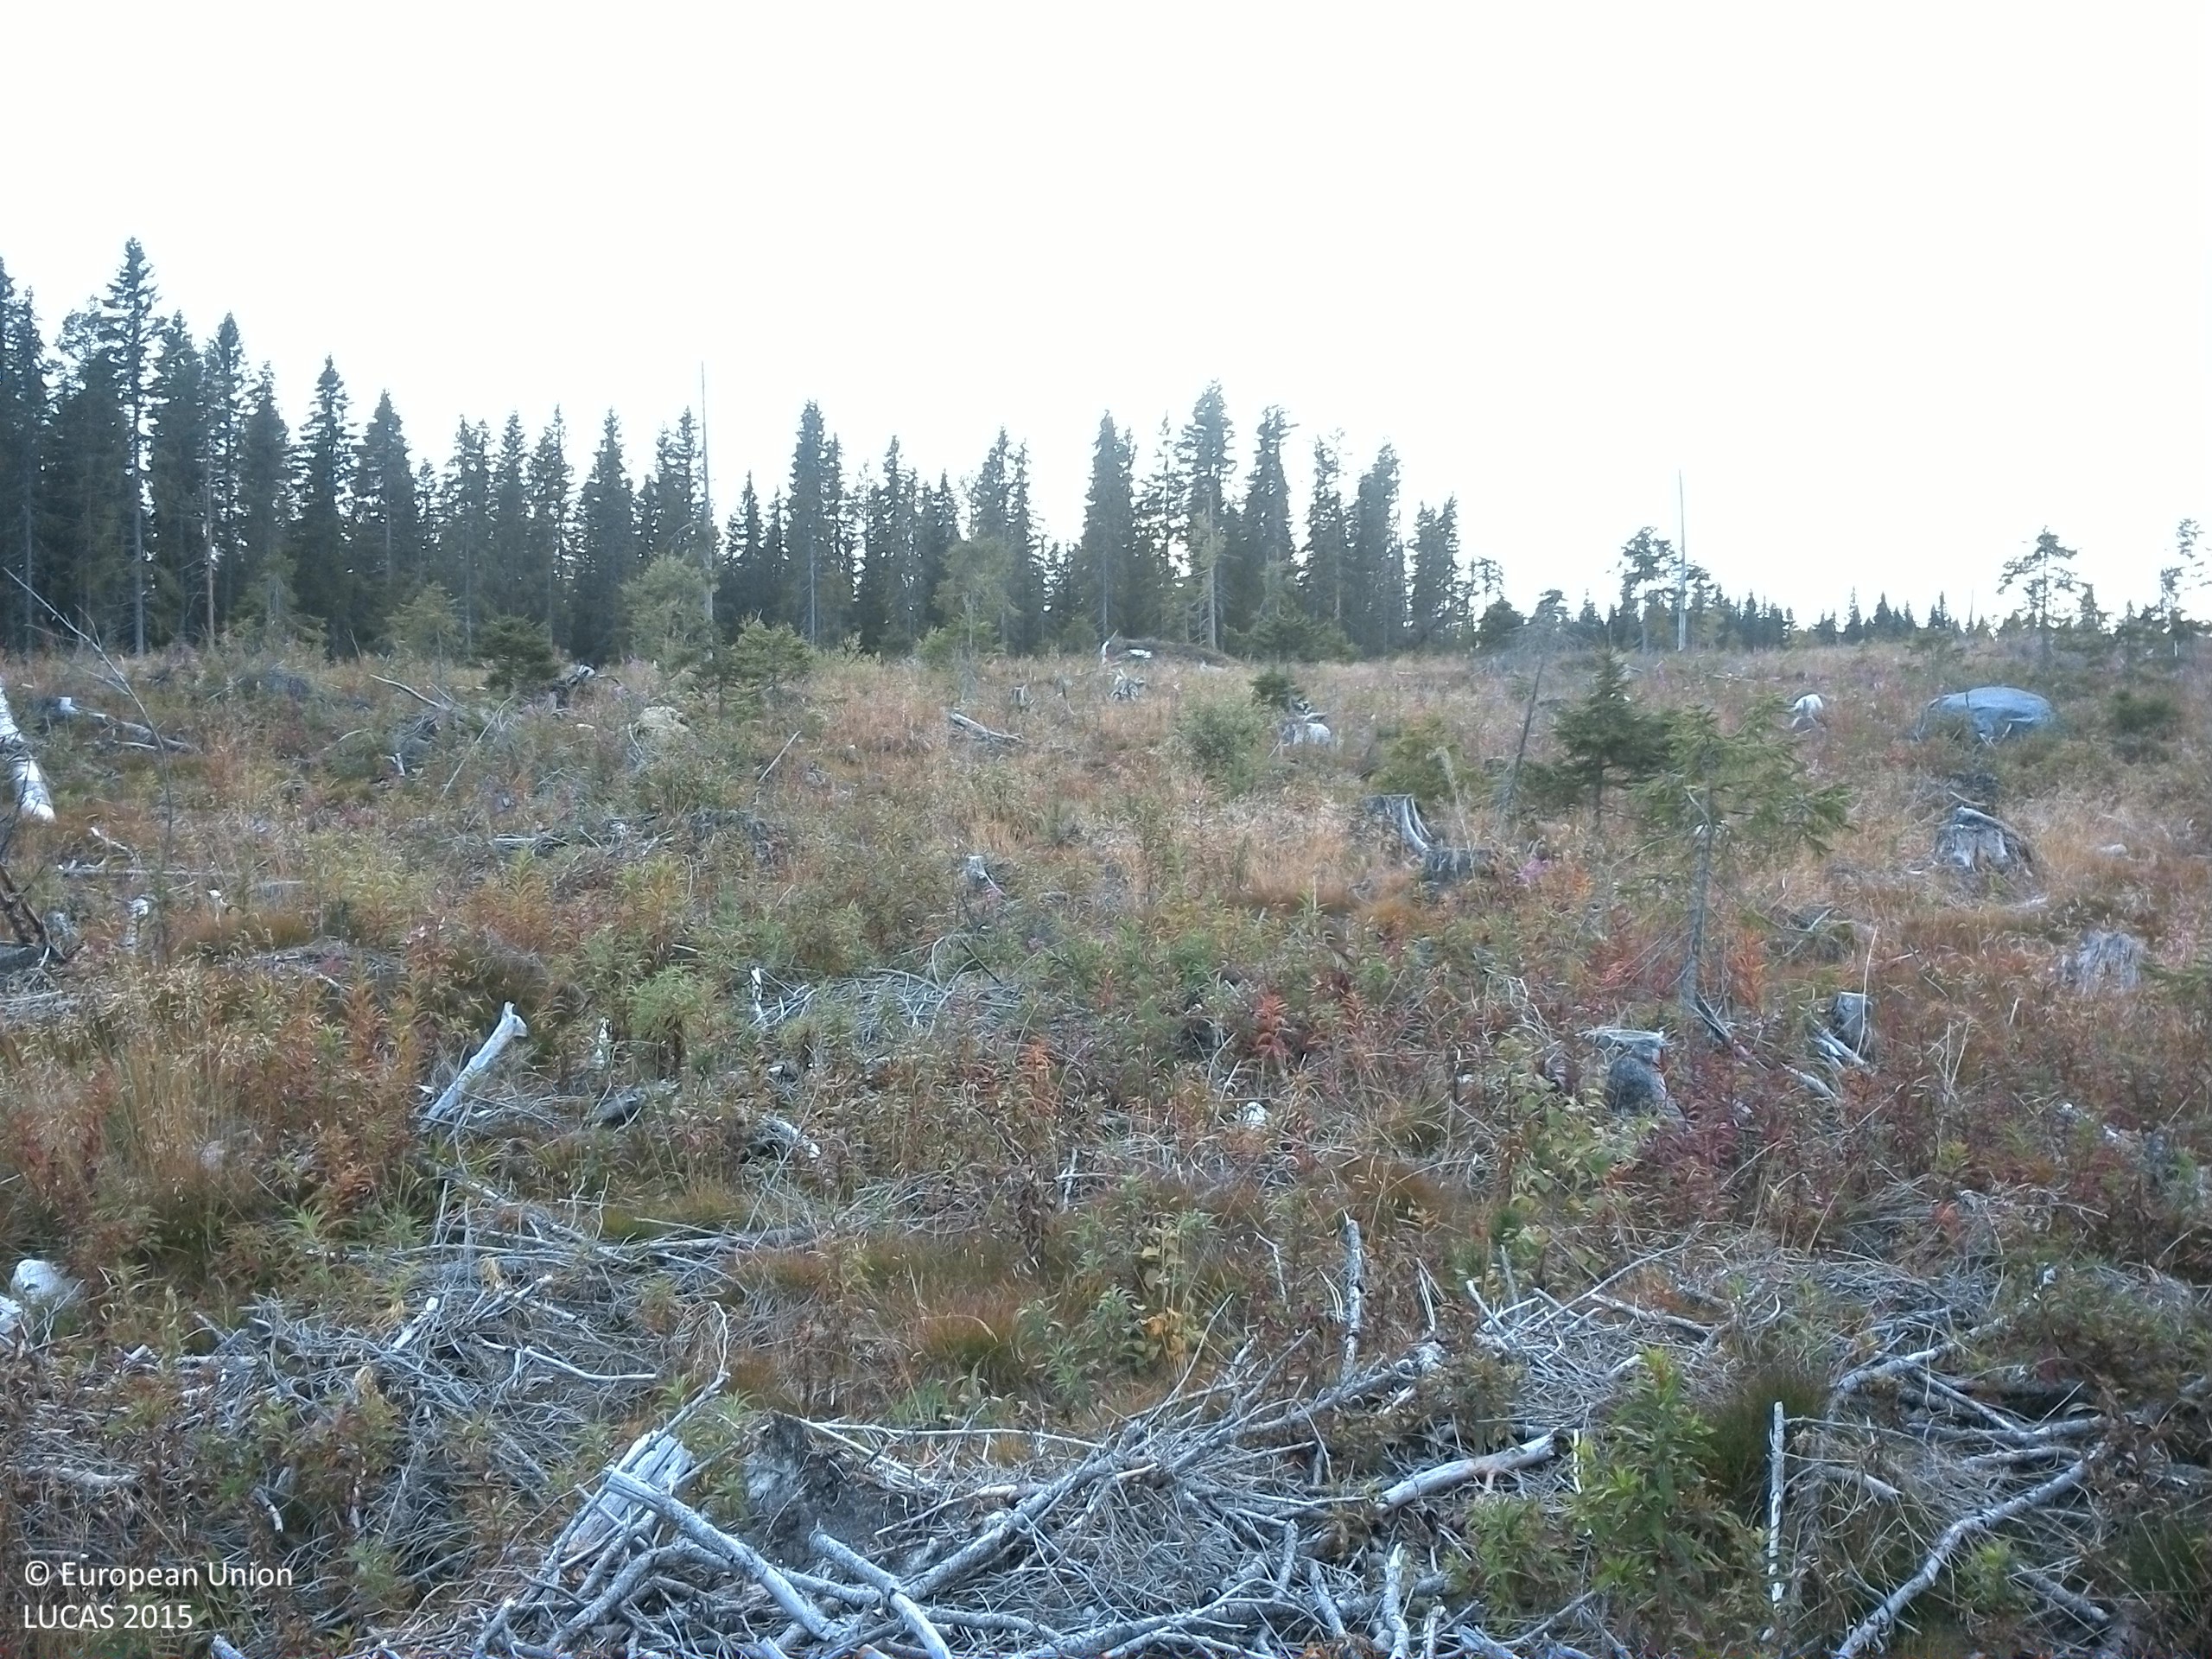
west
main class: Grassland
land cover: Grassland with sparse tree/shrub cover
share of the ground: > 75 %
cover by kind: herbaceous plants 85 %, coniferous forest trees 5 %, lichens and mosses 5 %, unconsolidated bare surface 5 %
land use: Forestry
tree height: < 5 m
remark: Clear cut
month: September
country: SE
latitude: 64.0799
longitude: 16.5932
